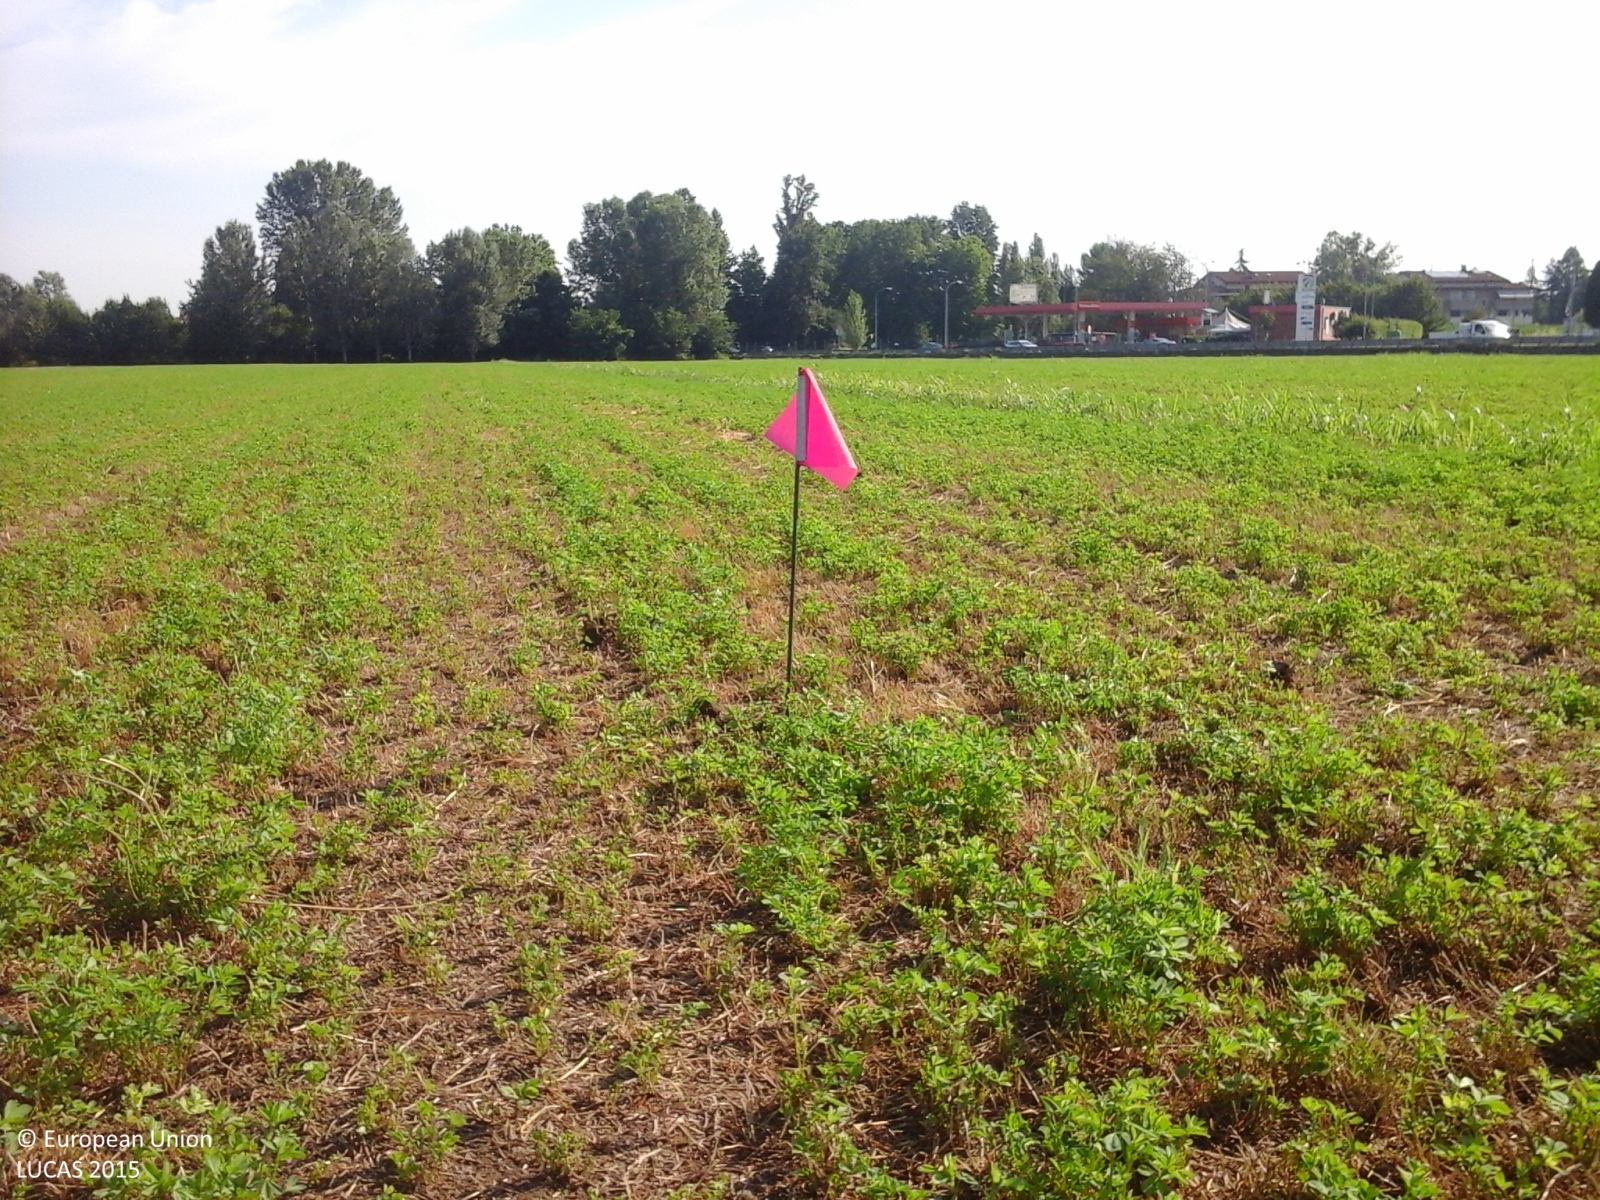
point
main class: Cropland
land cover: Lucerne
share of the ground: > 75 %
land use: Agriculture (excluding fallow land and kitchen gardens)
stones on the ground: < 10 %
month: June
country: IT
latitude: 44.5985
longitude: 10.9680
